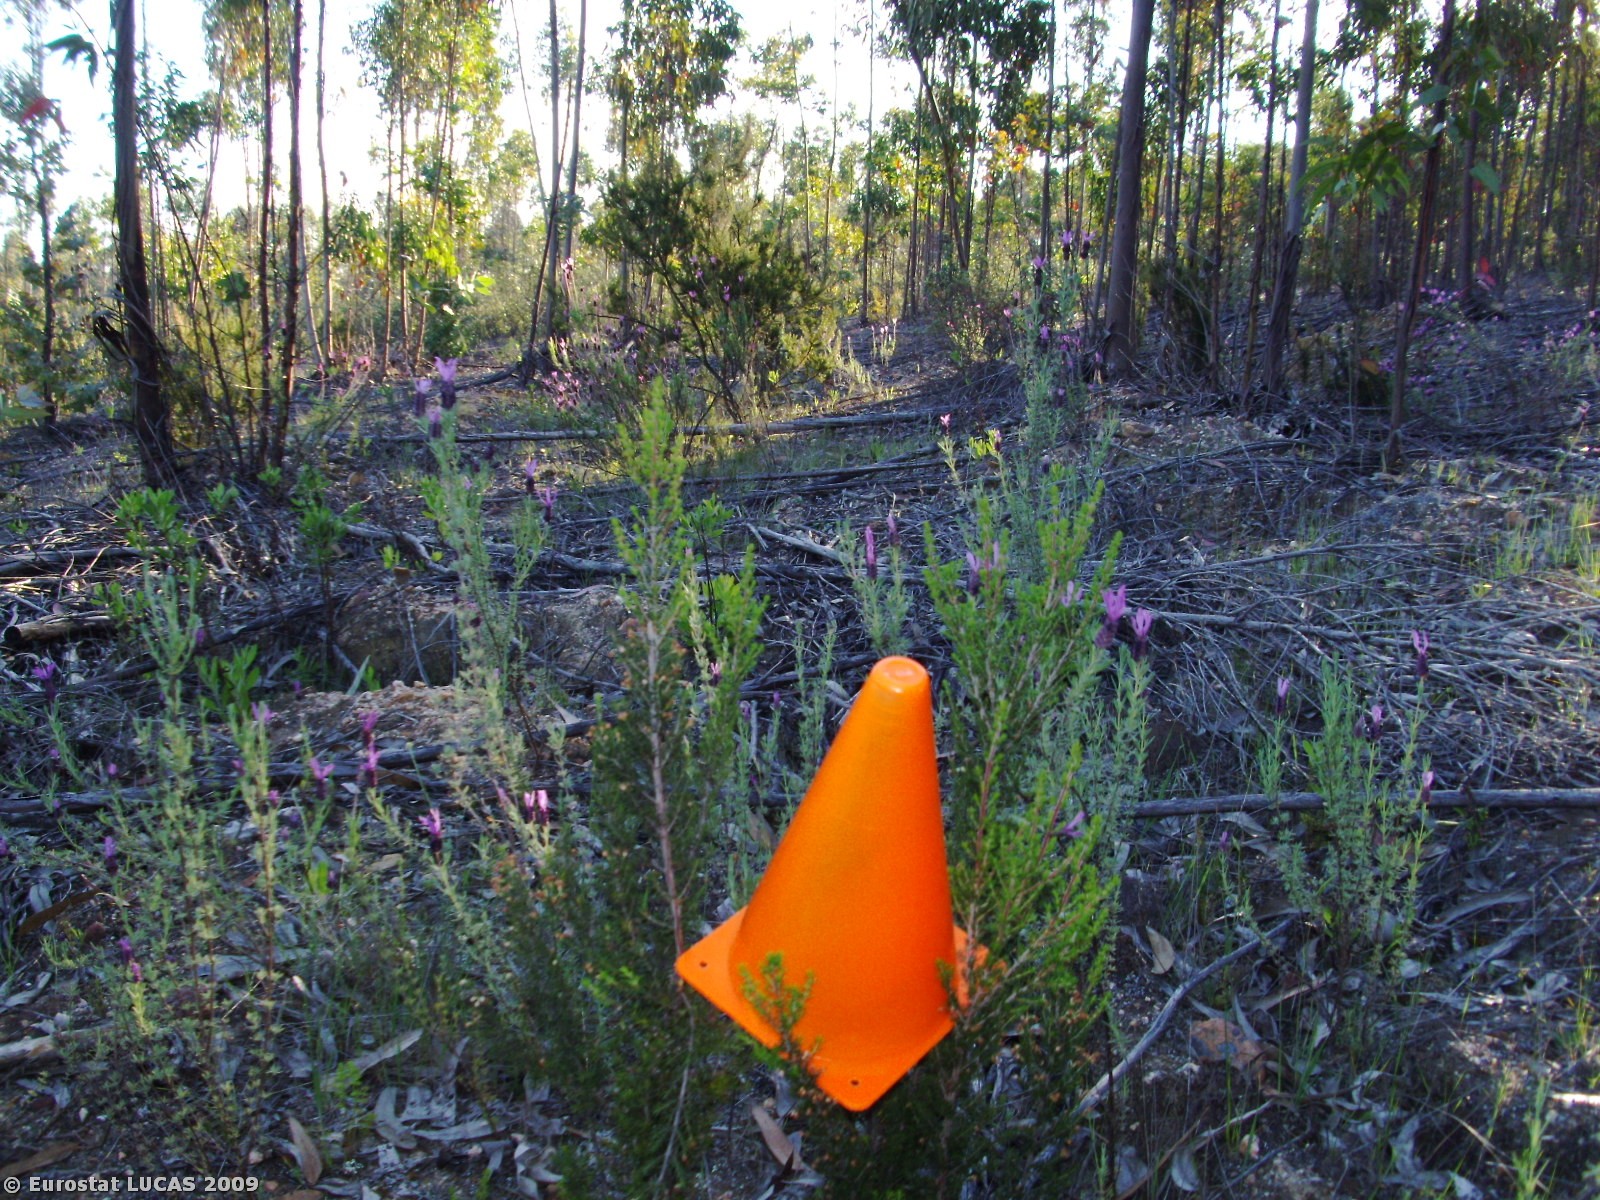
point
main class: Woodland
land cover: Broadleaved woodland
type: plantations and self-sown exotic forest
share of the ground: > 75 %
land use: Forestry
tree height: > 5 m
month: May
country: PT
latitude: 39.6862
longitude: -7.5532
